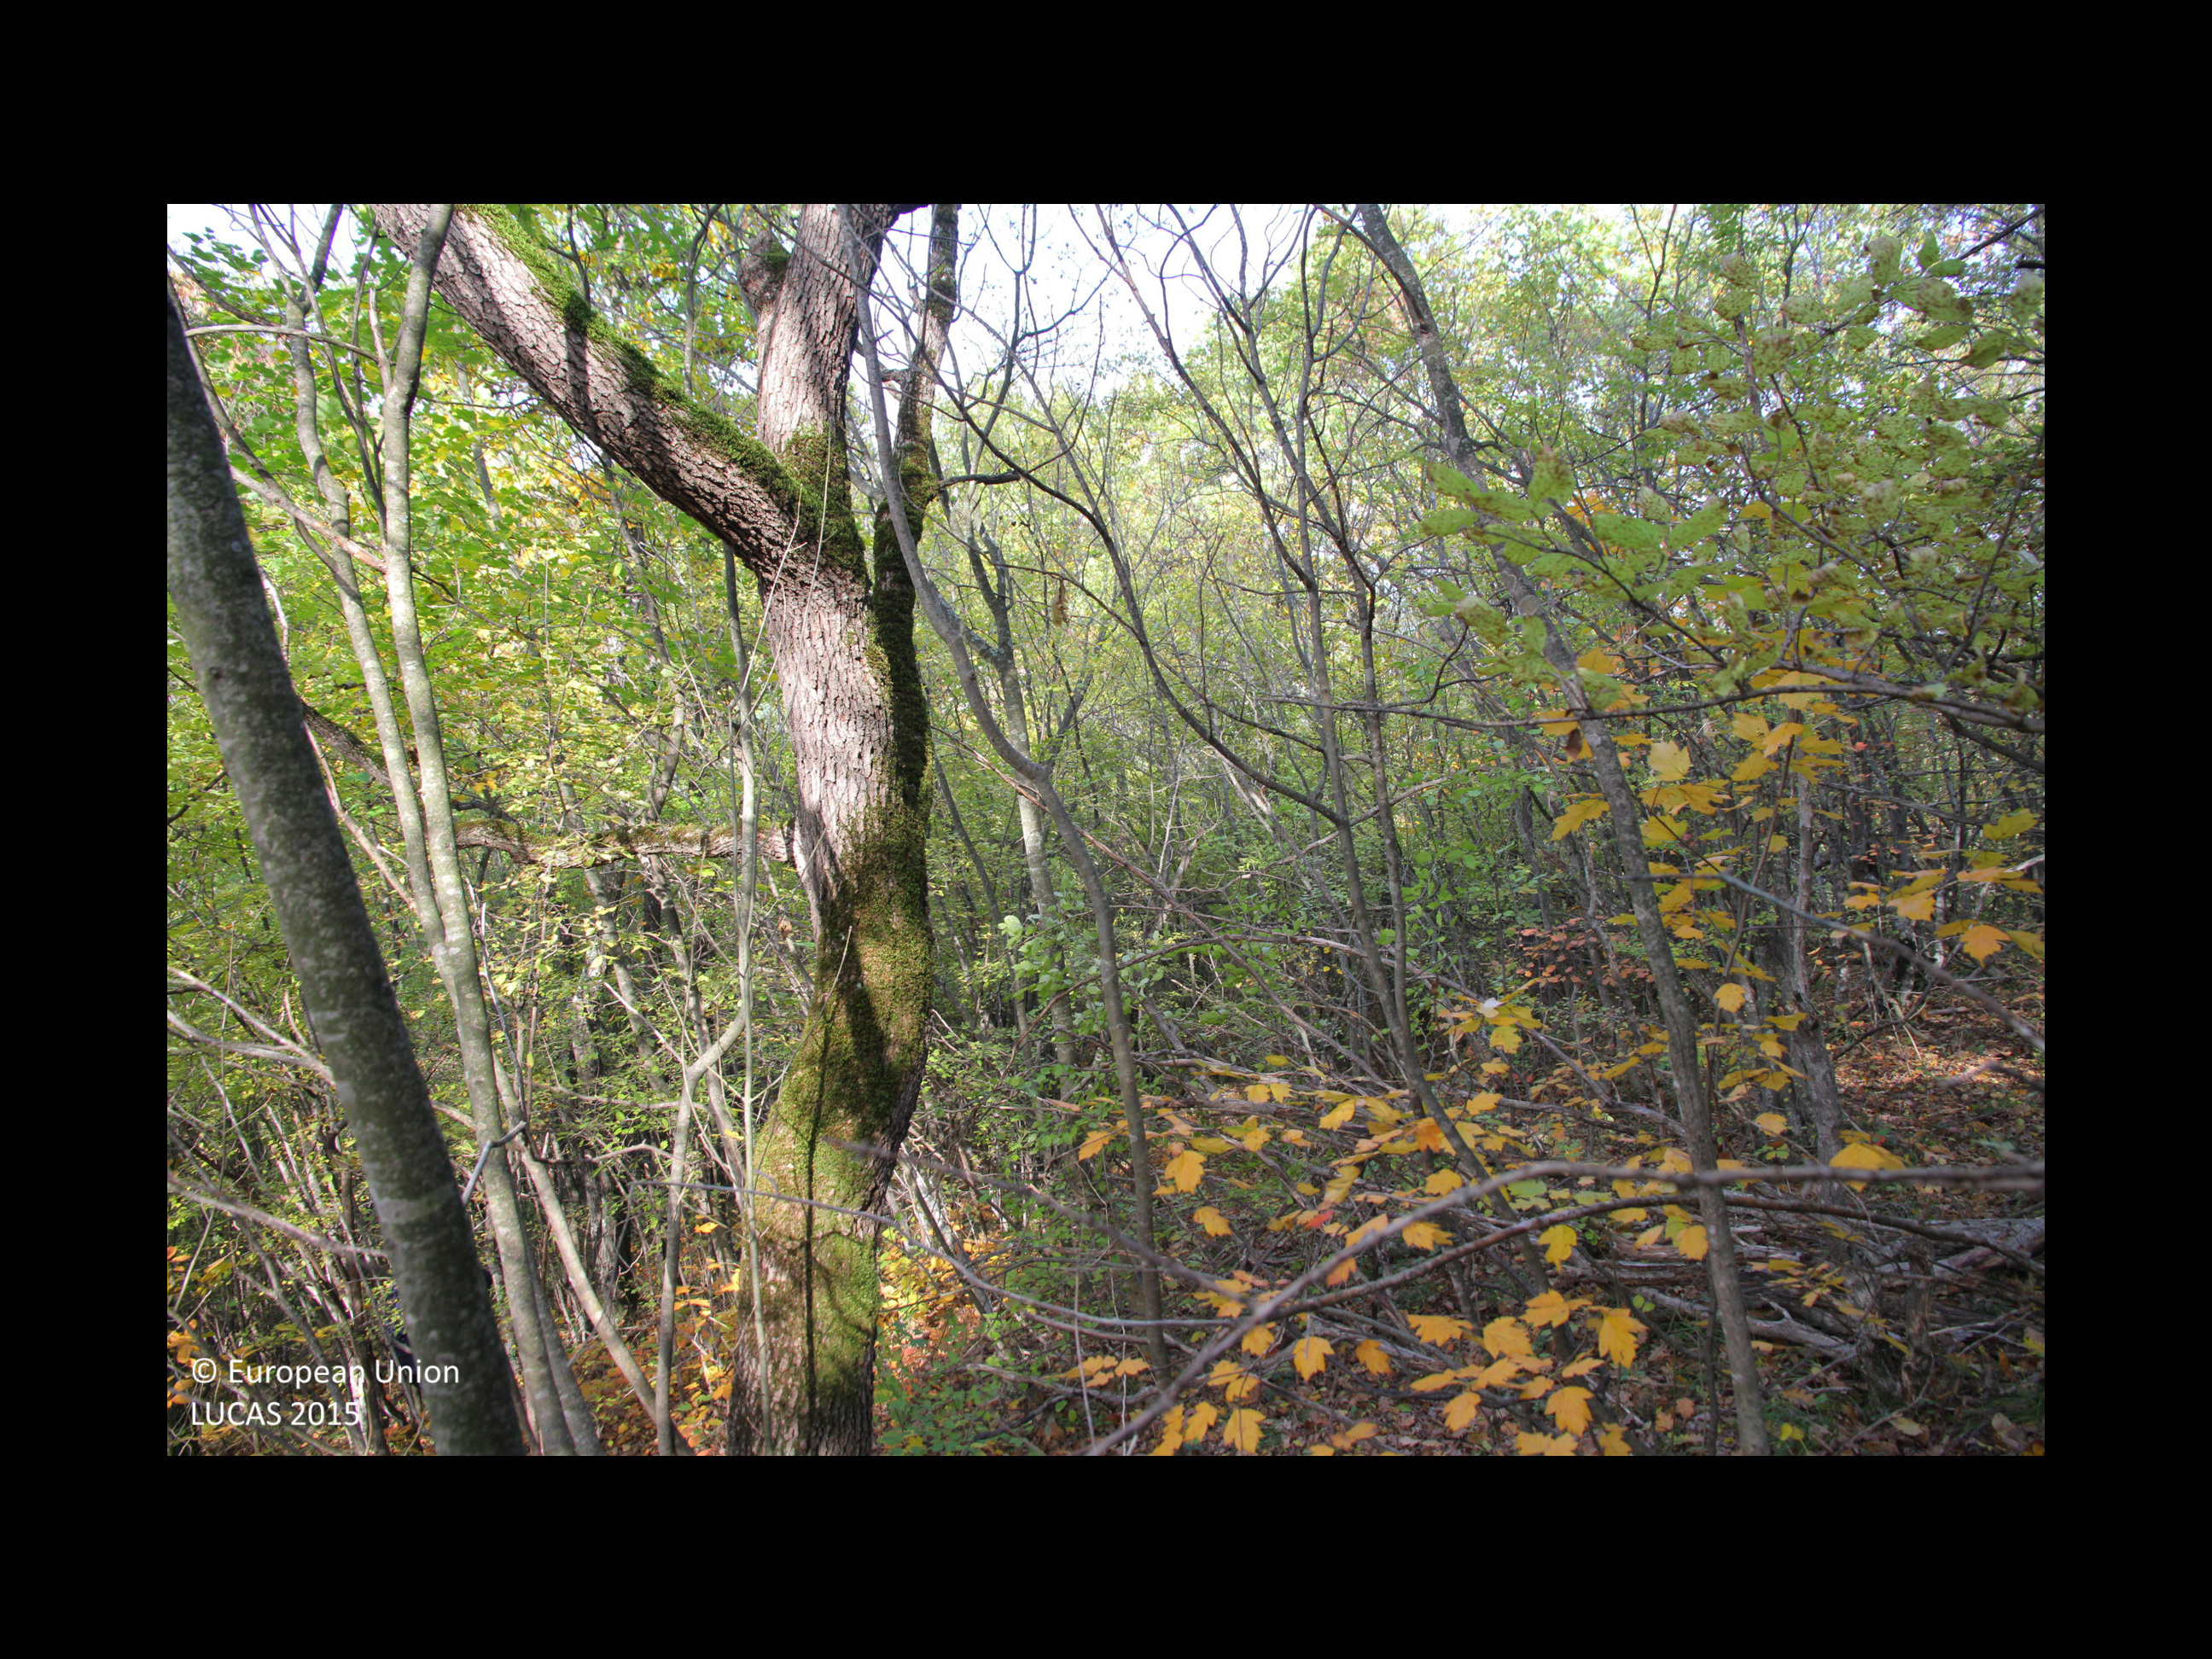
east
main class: Woodland
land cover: Broadleaved woodland
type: mesophytic deciduous forest
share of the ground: > 75 %
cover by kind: broadleaved forest trees 100 %
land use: Forestry
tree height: > 5 m
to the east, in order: Broadleaved woodland; Rivers and streams; Broadleaved woodland
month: October
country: BG
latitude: 43.1320
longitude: 26.8144
